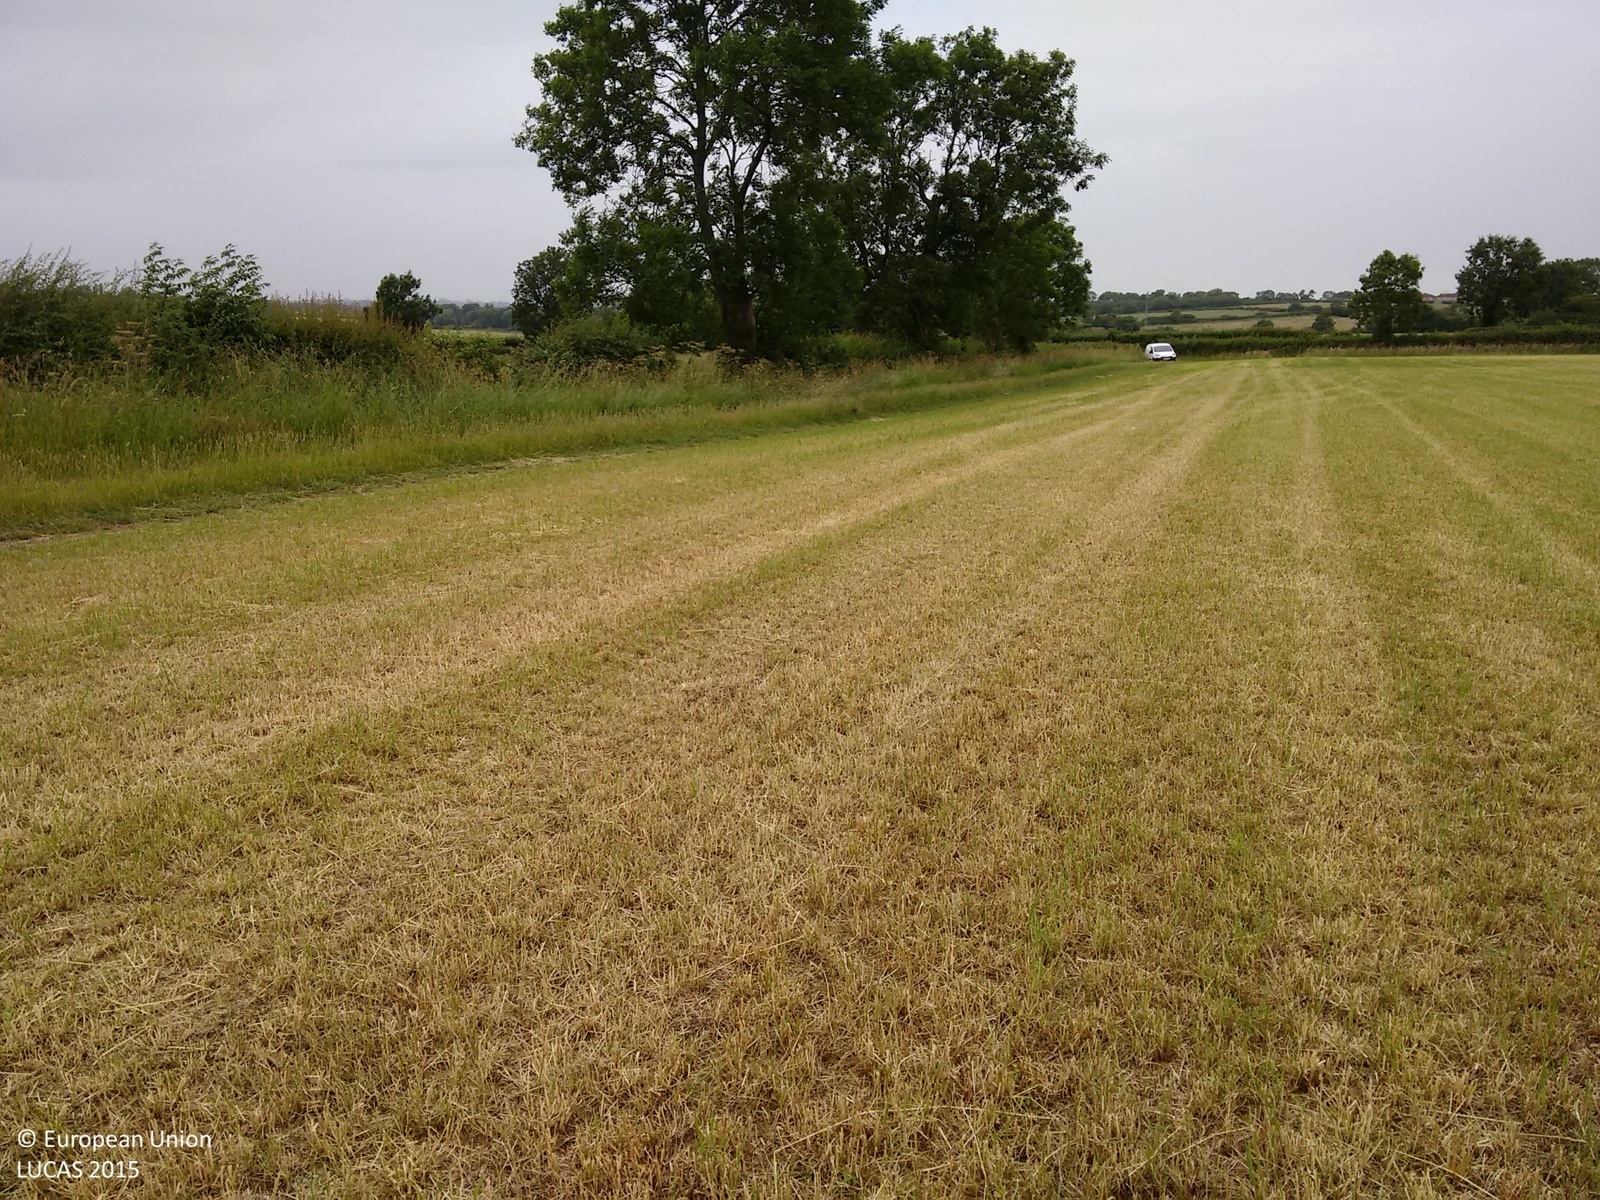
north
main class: Grassland
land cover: Grassland without tree/shrub cover
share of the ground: > 75 %
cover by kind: herbaceous plants 100 %
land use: Agriculture (excluding fallow land and kitchen gardens)
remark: Harvested field
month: July
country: GB
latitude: 52.8255
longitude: -1.0115
